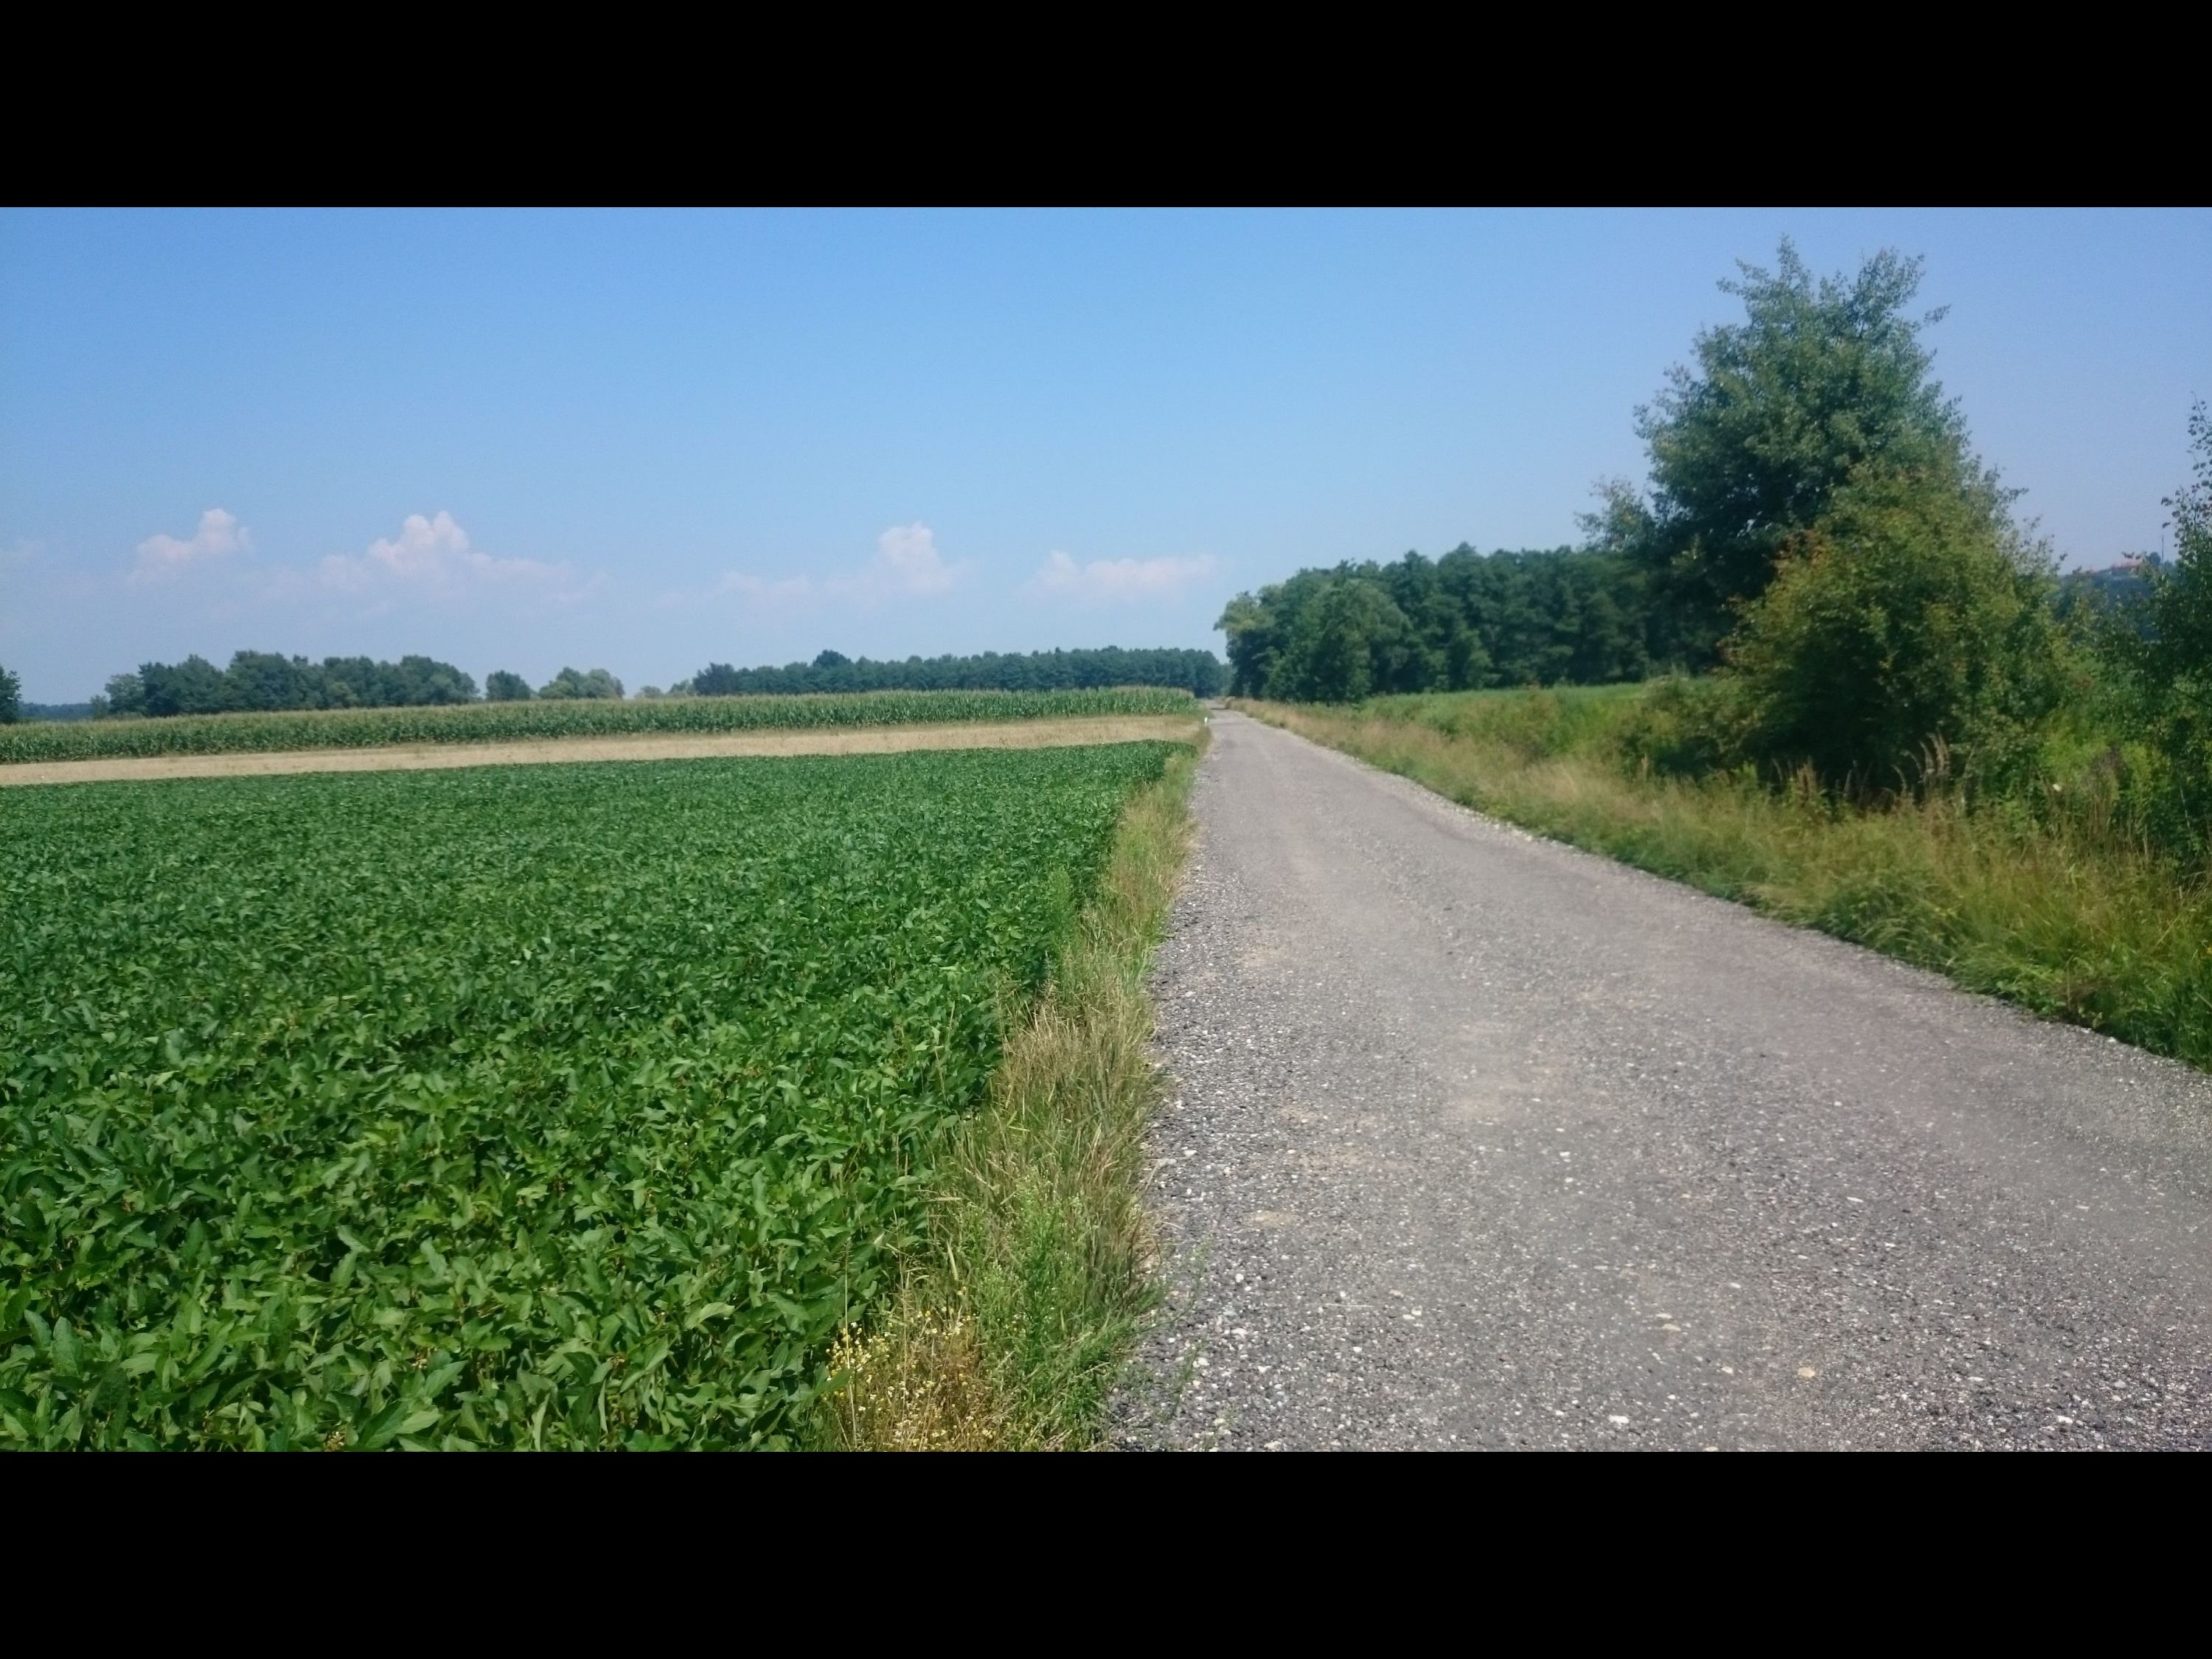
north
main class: Cropland
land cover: Soya
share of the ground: > 75 %
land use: Agriculture (excluding fallow land and kitchen gardens)
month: July
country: AT
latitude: 47.0979
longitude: 16.1016
